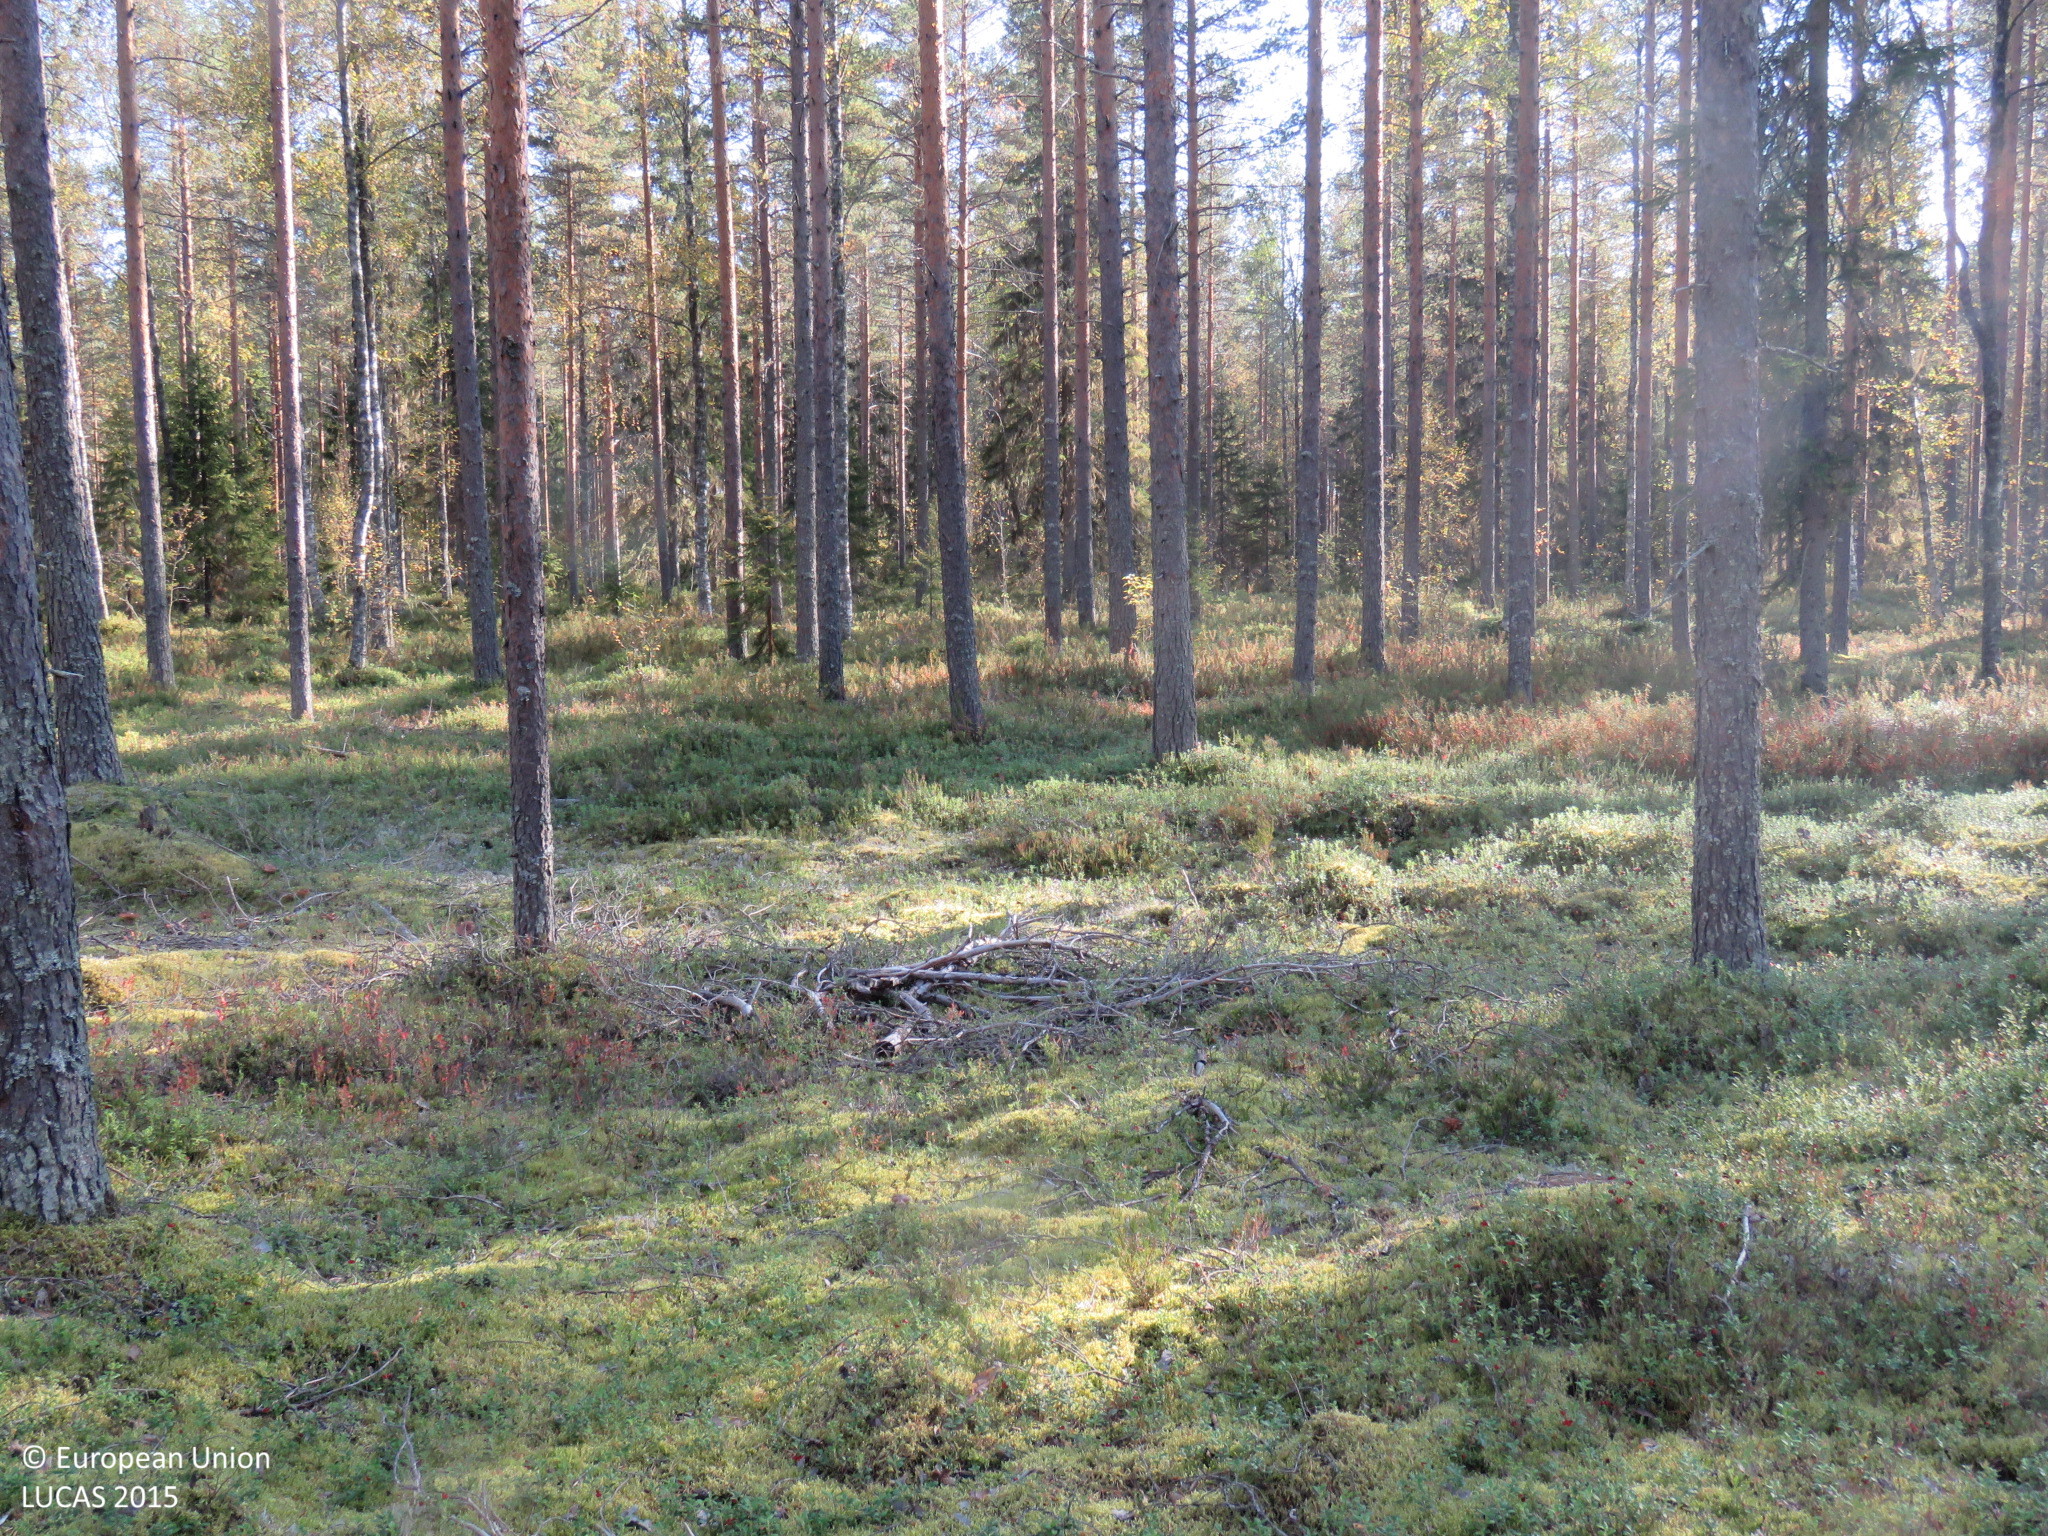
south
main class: Woodland
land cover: Pine dominated coniferous woodland
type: boreal forest
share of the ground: > 75 %
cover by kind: coniferous forest trees 75 %, shrubs 15 %, lichens and mosses 10 %
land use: Forestry
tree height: > 5 m
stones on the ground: < 10 %
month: September
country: FI
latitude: 64.9648
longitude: 26.3922
